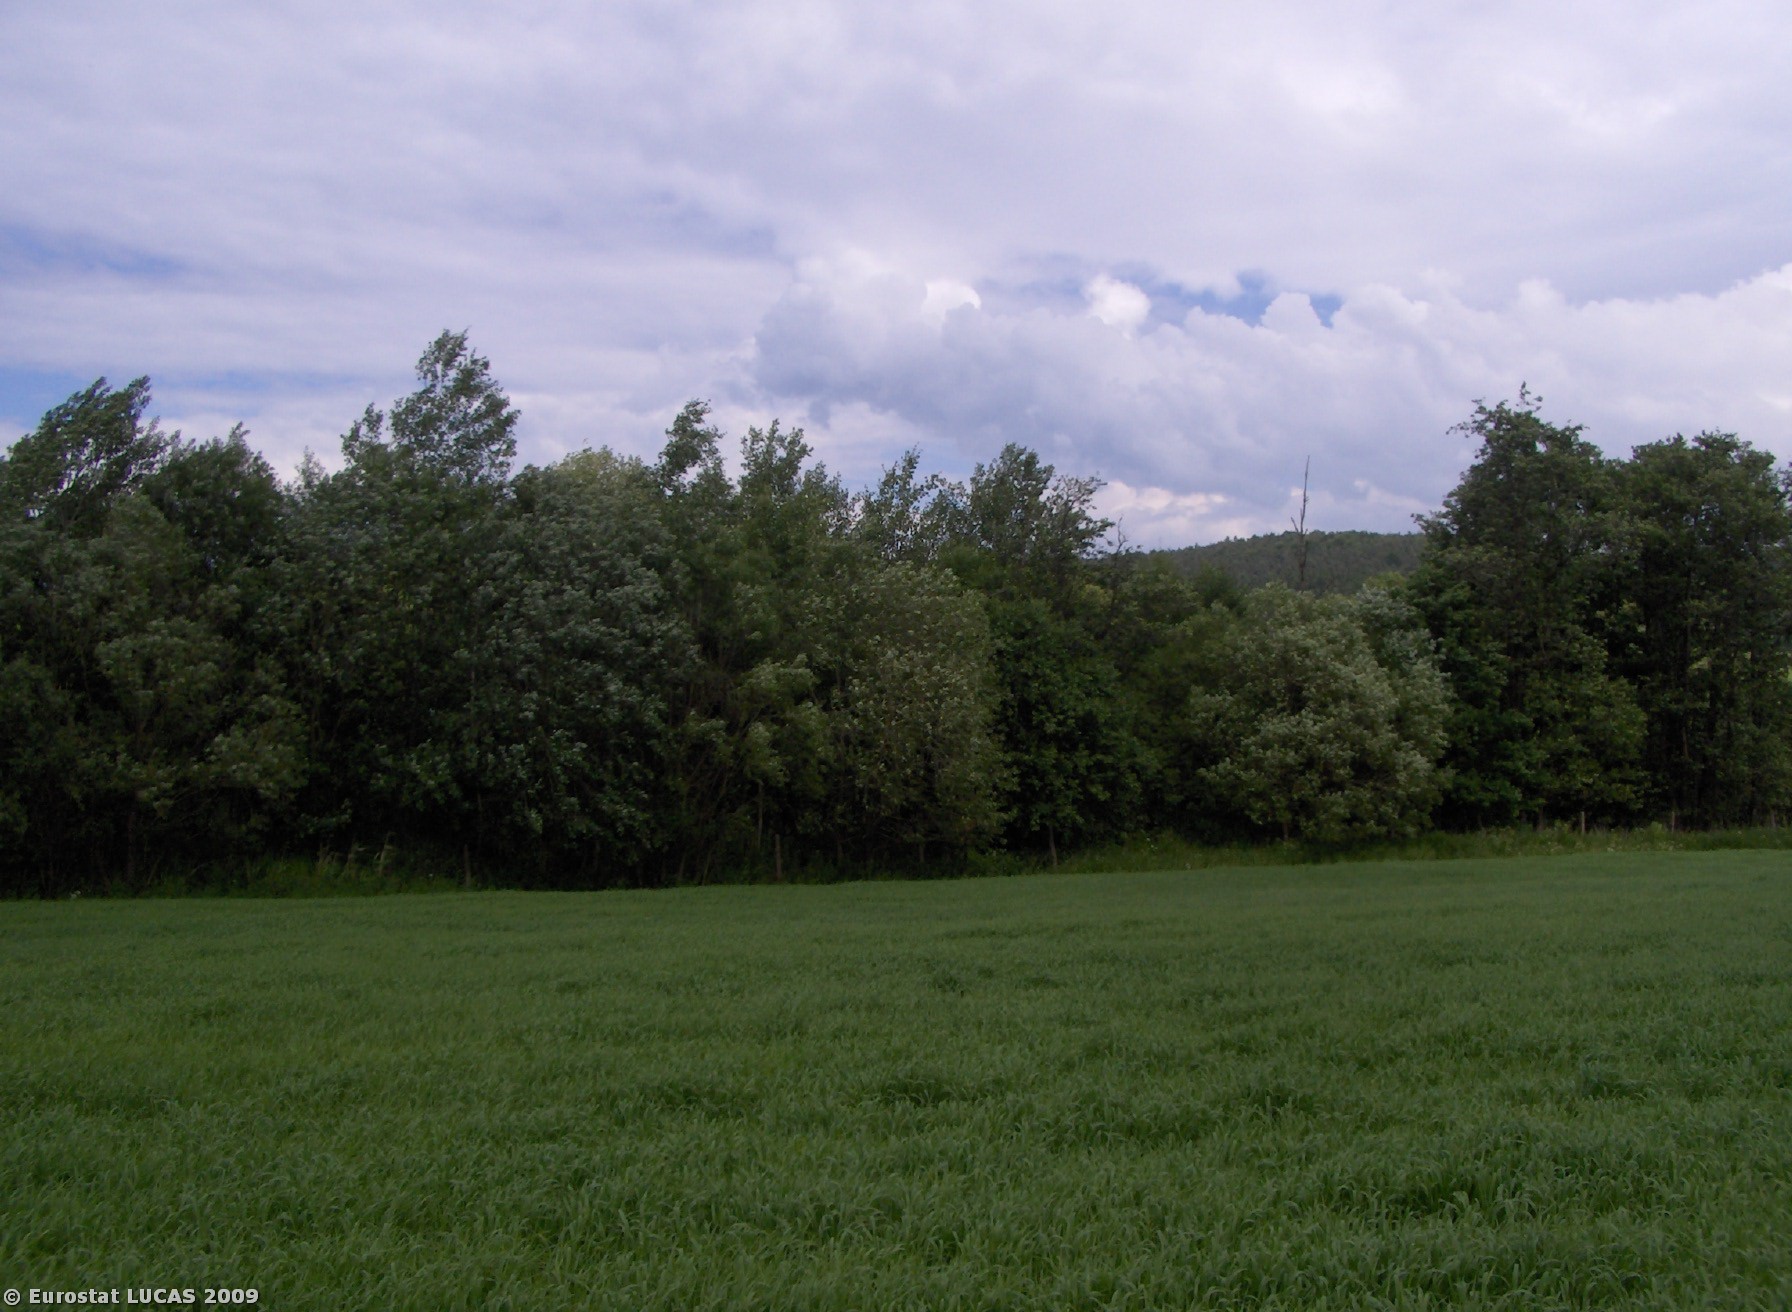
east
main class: Cropland
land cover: Barley
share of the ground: > 75 %
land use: Agriculture (excluding fallow land and kitchen gardens)
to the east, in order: Barley; Fences; Broadleaved woodland; Inland water bodies; Broadleaved woodland; Ditches and canals; Broadleaved woodland; Grassland without tree/shrub cover
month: June
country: CZ
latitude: 48.9915
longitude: 14.1689
